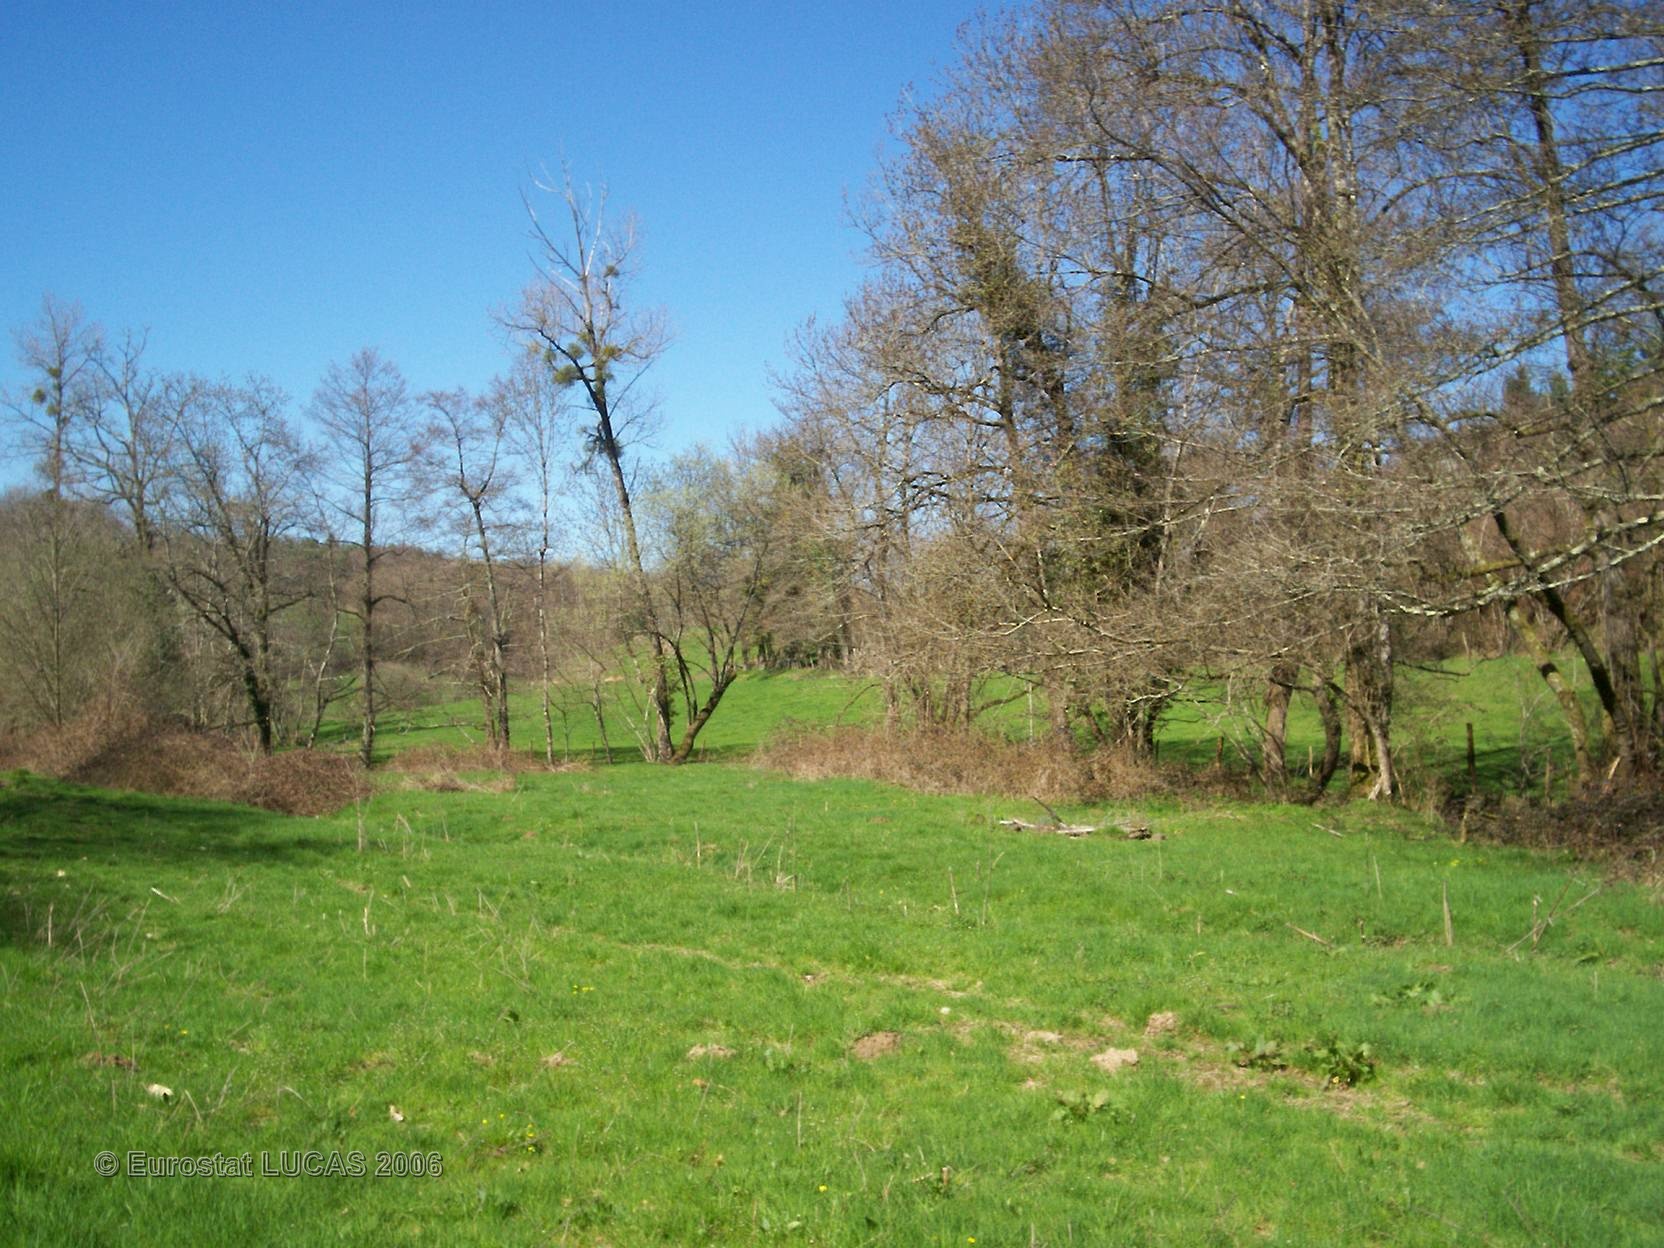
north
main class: Grassland
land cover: Grassland with sparse tree/shrub cover
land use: Unused
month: April
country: FR
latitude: 45.2994
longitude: 1.6424
